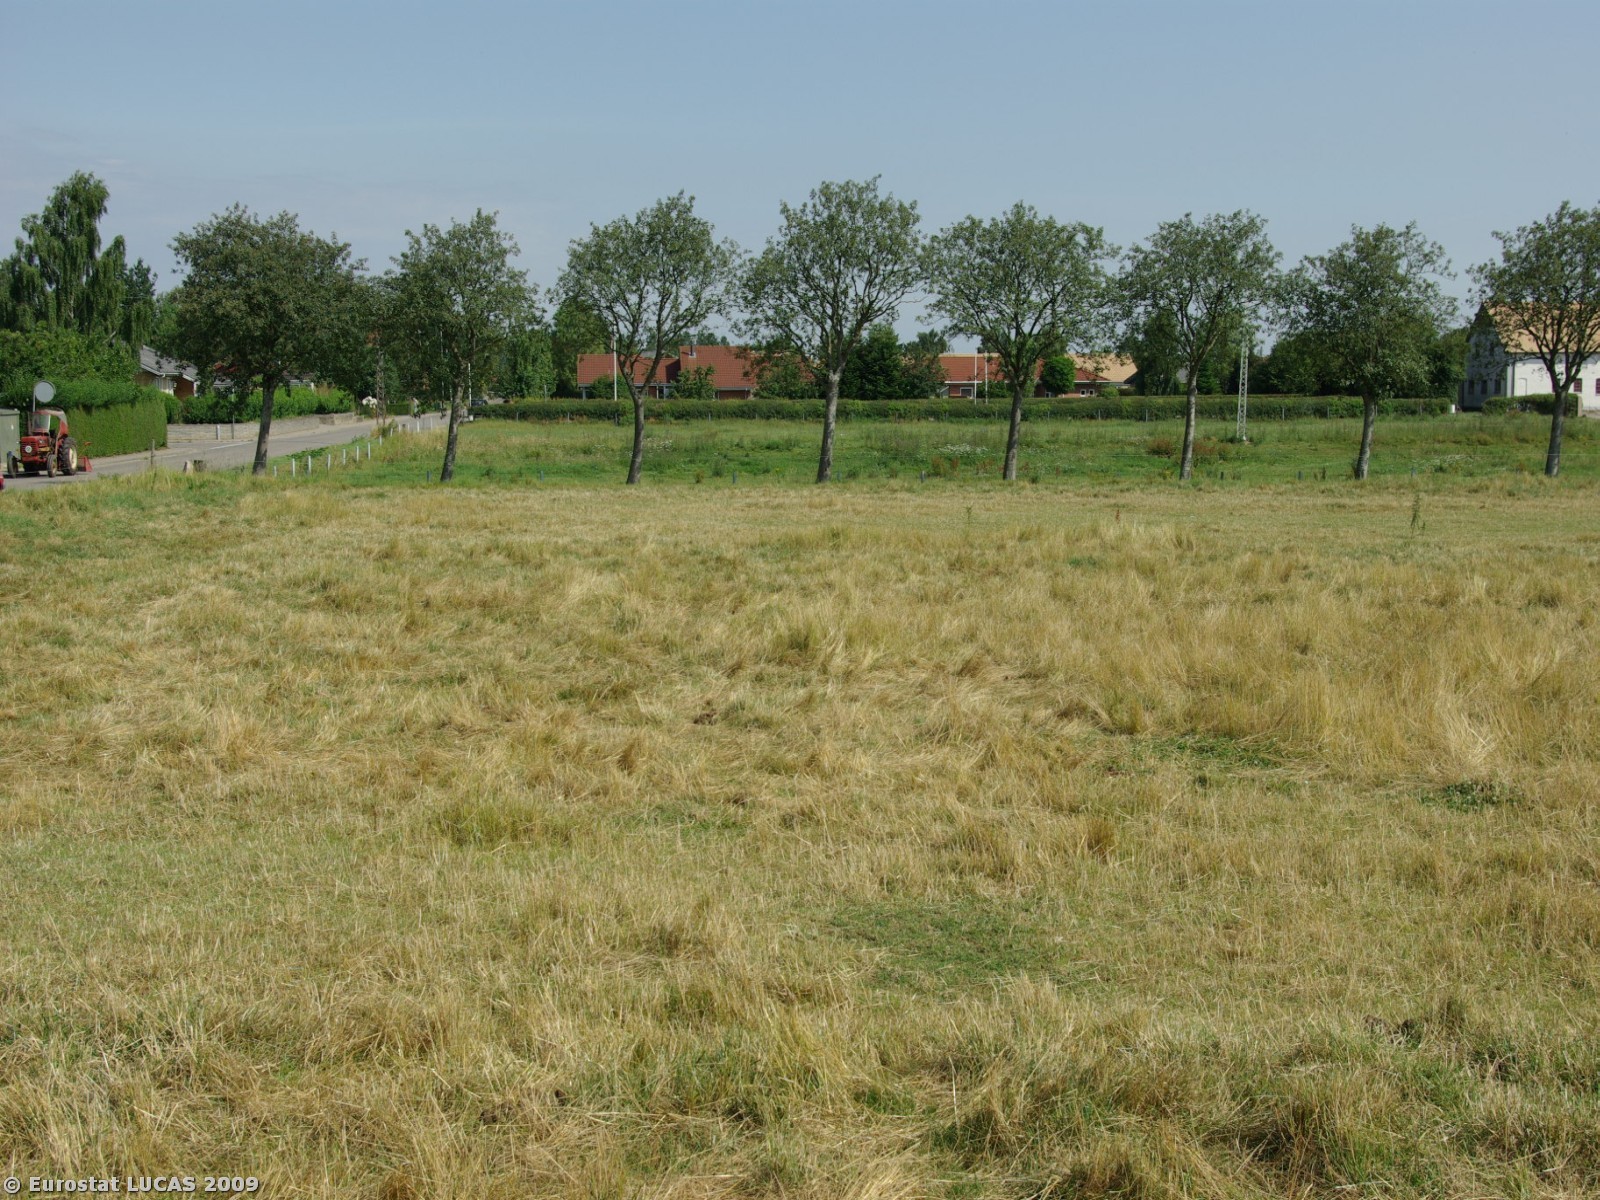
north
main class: Grassland
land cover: Grassland without tree/shrub cover
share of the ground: > 75 %
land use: Agriculture (excluding fallow land and kitchen gardens)
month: July
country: DK
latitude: 54.9472
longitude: 9.7036
